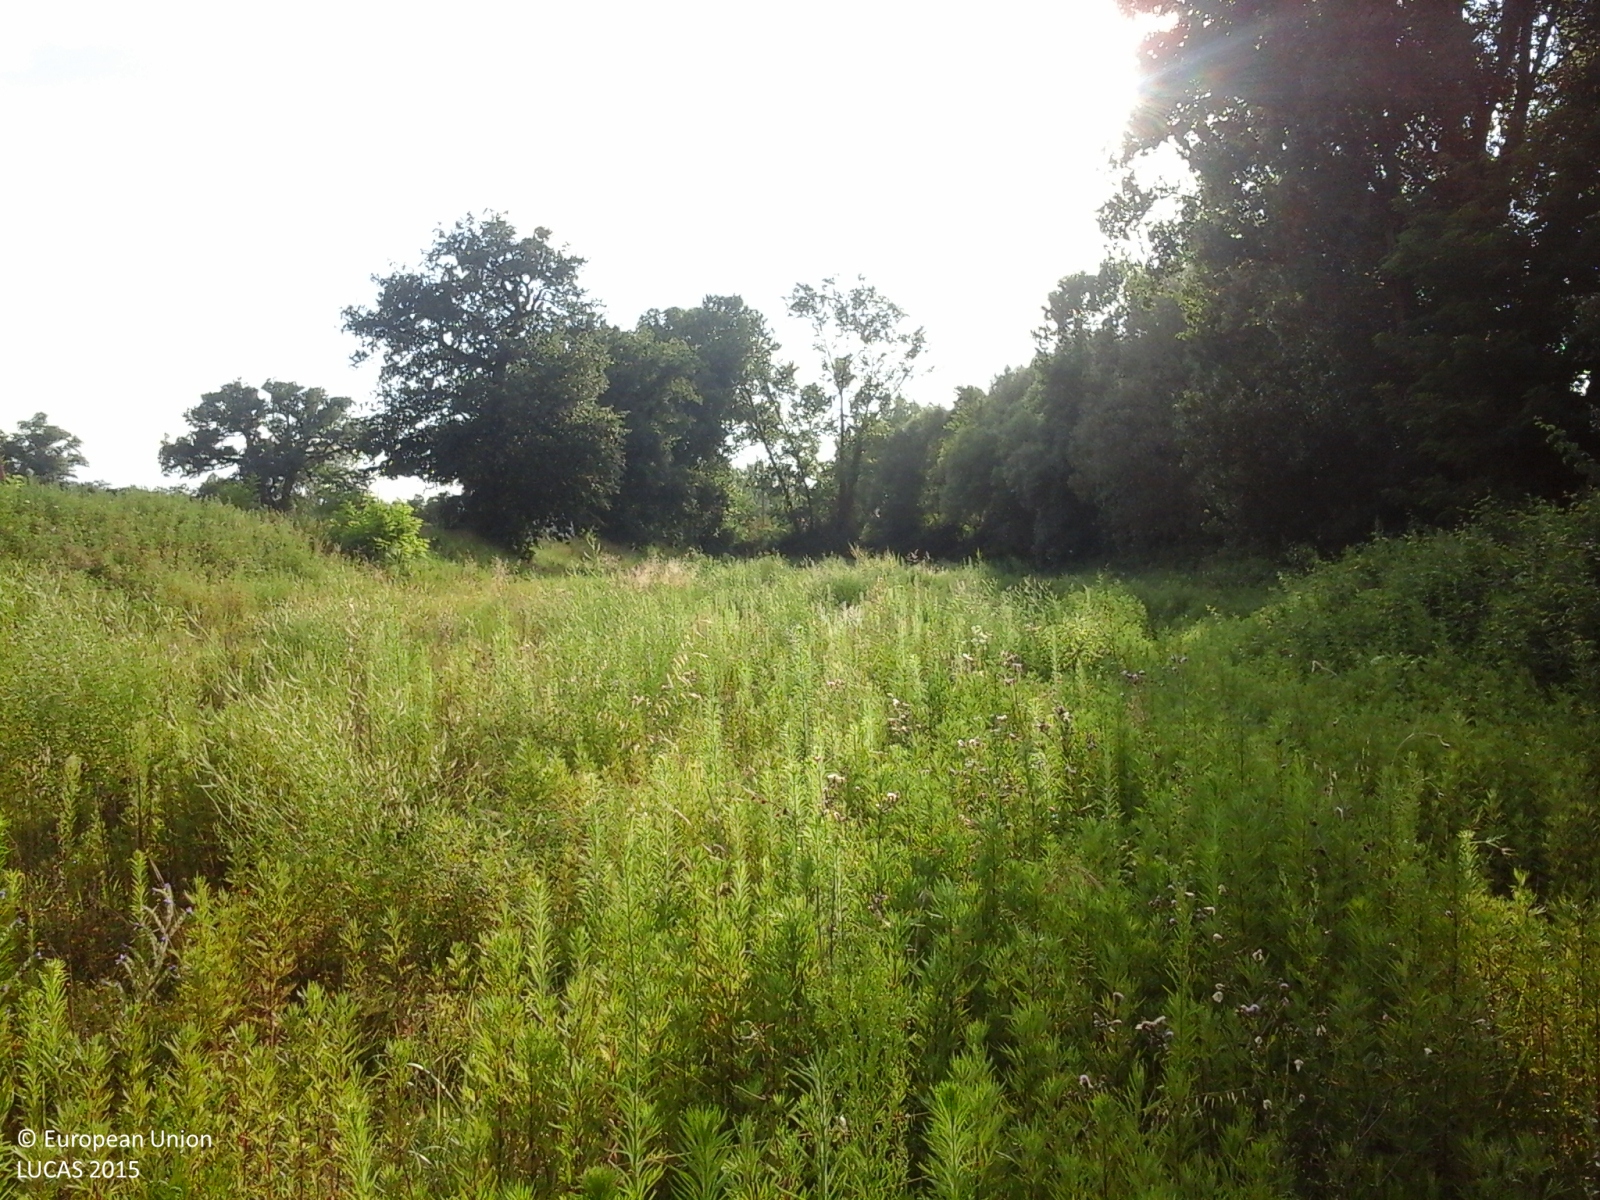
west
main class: Grassland
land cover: Grassland without tree/shrub cover
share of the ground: 50 - 75 %
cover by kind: herbaceous plants 100 %
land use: Agriculture (excluding fallow land and kitchen gardens)
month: June
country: IT
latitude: 43.3531
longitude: 13.4828
